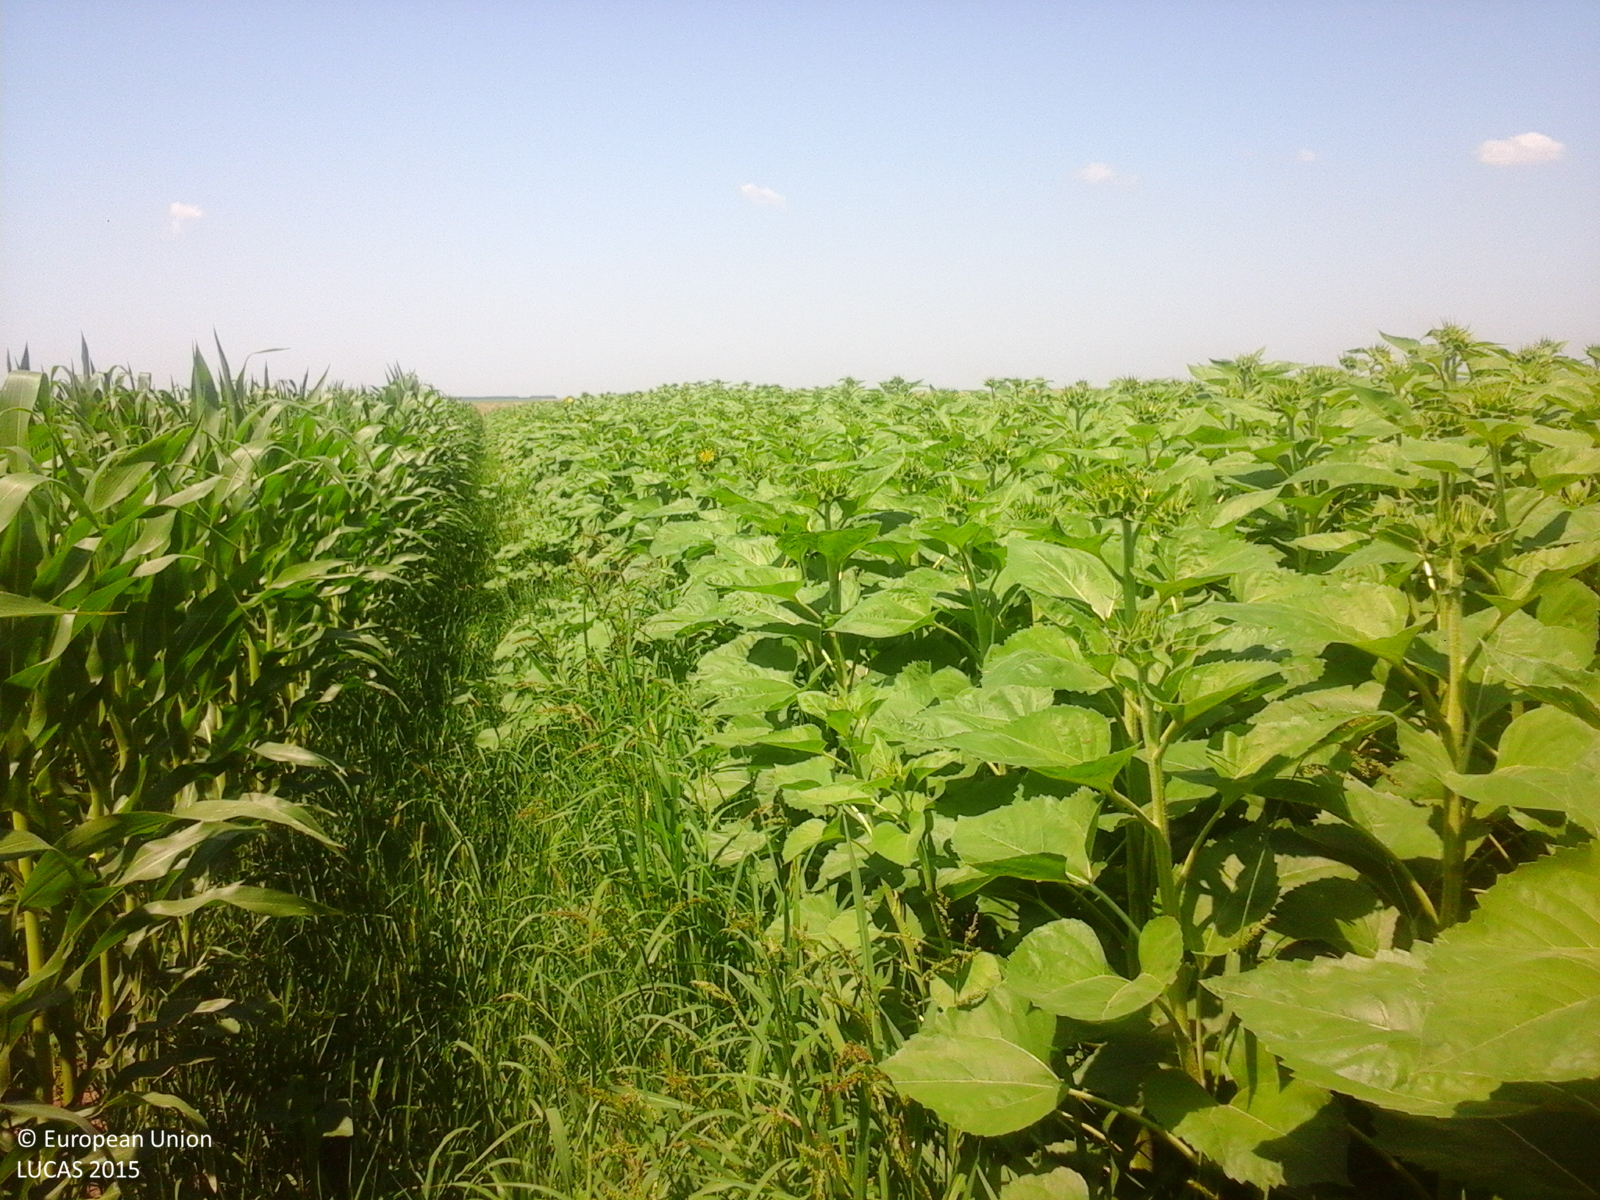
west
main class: Cropland
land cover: Sunflower
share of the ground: > 75 %
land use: Agriculture (excluding fallow land and kitchen gardens)
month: July
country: RO
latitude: 44.4905
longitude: 24.5456
